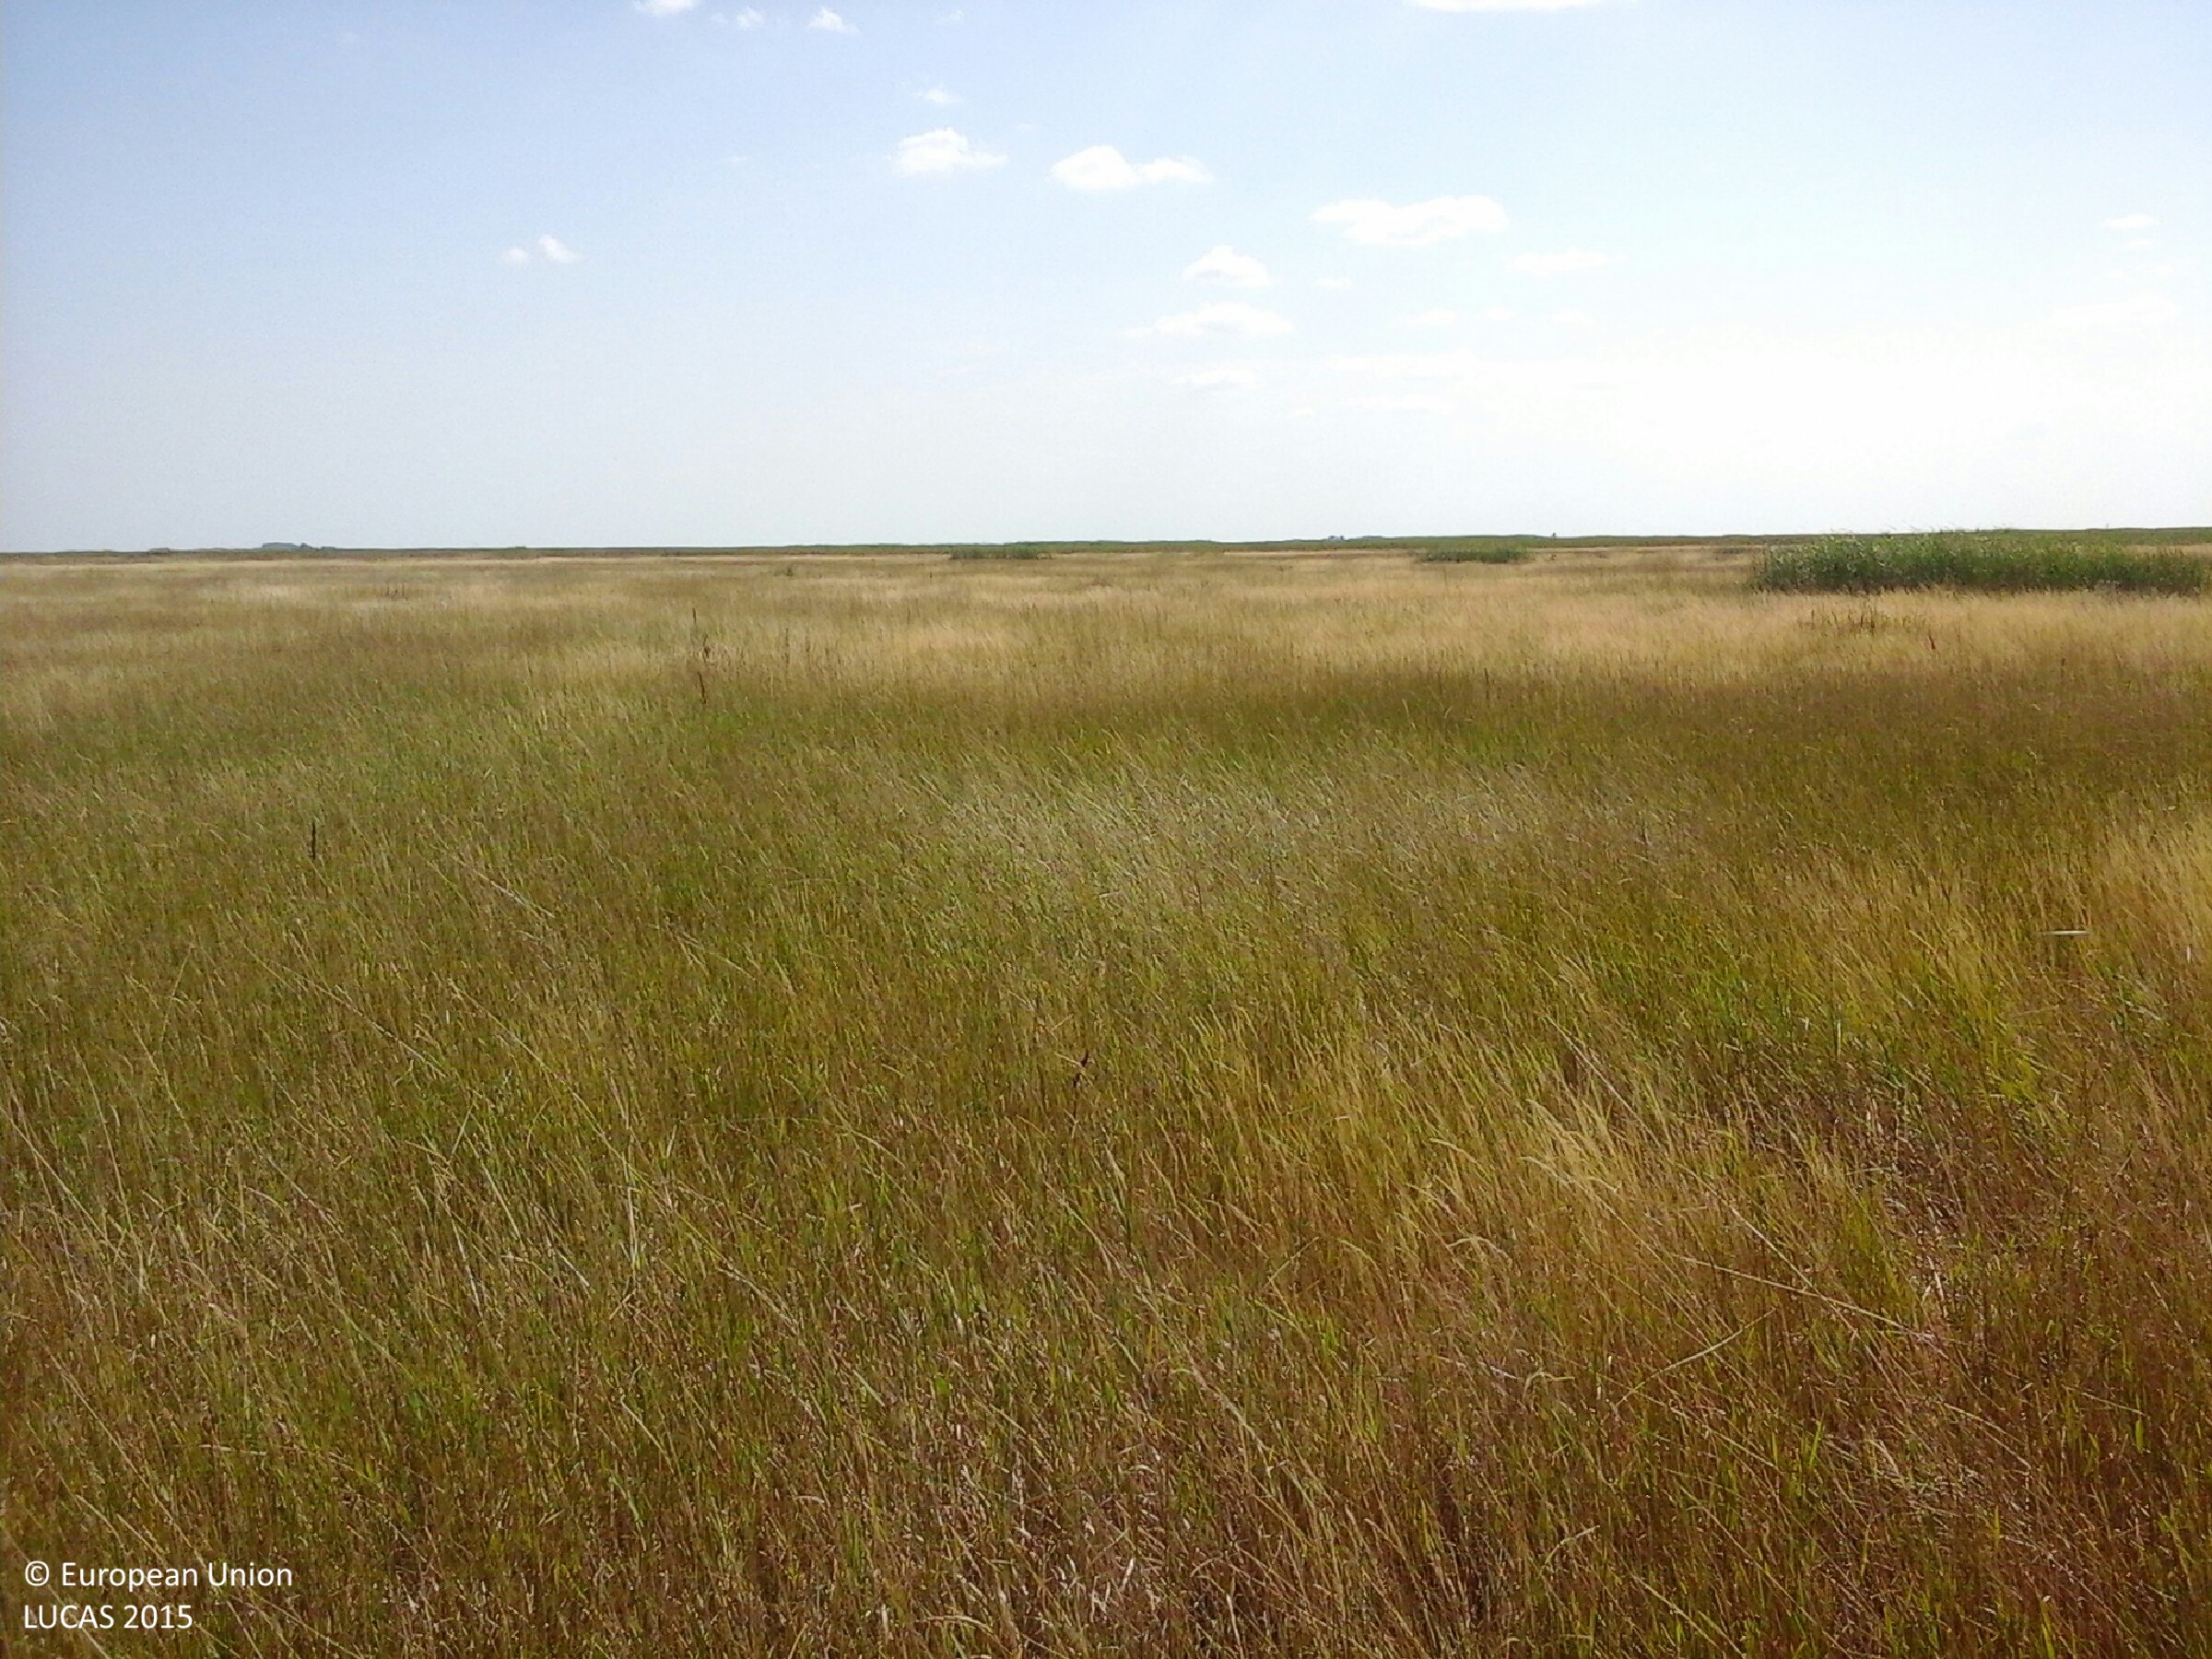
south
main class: Grassland
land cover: Grassland without tree/shrub cover
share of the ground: > 75 %
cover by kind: herbaceous plants 100 %
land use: Agriculture (excluding fallow land and kitchen gardens)
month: August
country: HU
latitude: 47.4350
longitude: 21.0015
